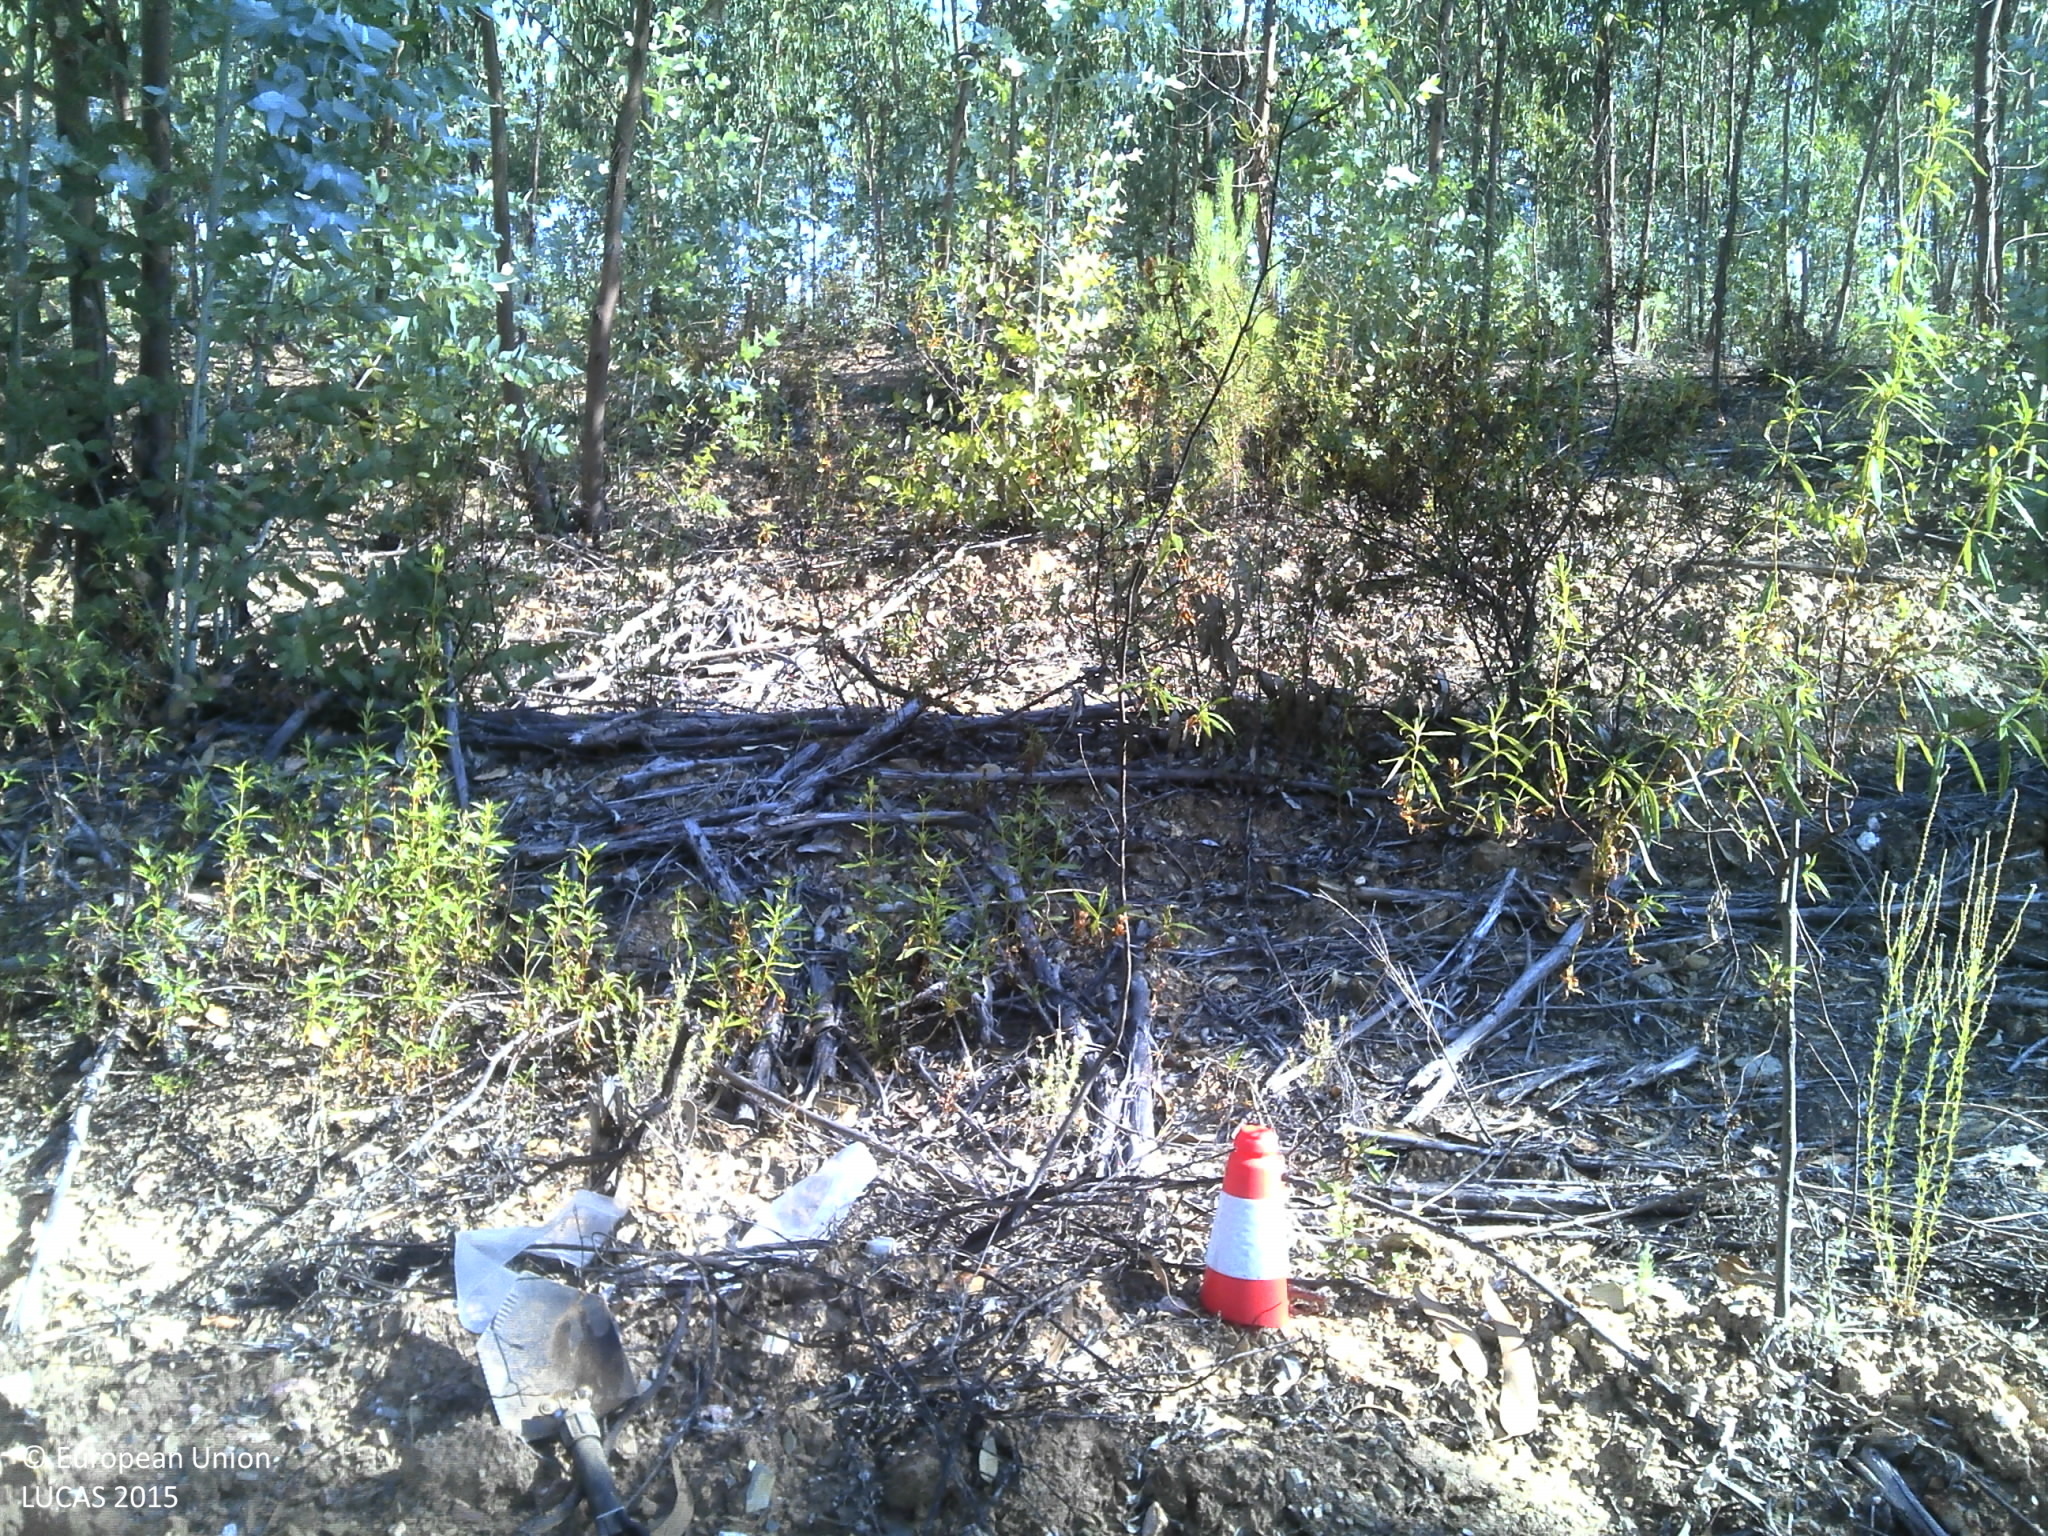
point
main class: Woodland
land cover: Broadleaved woodland
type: exotic forest
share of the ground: 25 - 50 %
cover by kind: broadleaved forest trees 50 %, unconsolidated bare surface 35 %, shrubs 15 %
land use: Forestry
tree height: > 5 m
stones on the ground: 10 - 25 %
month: July
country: PT
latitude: 39.7782
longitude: -7.5547
